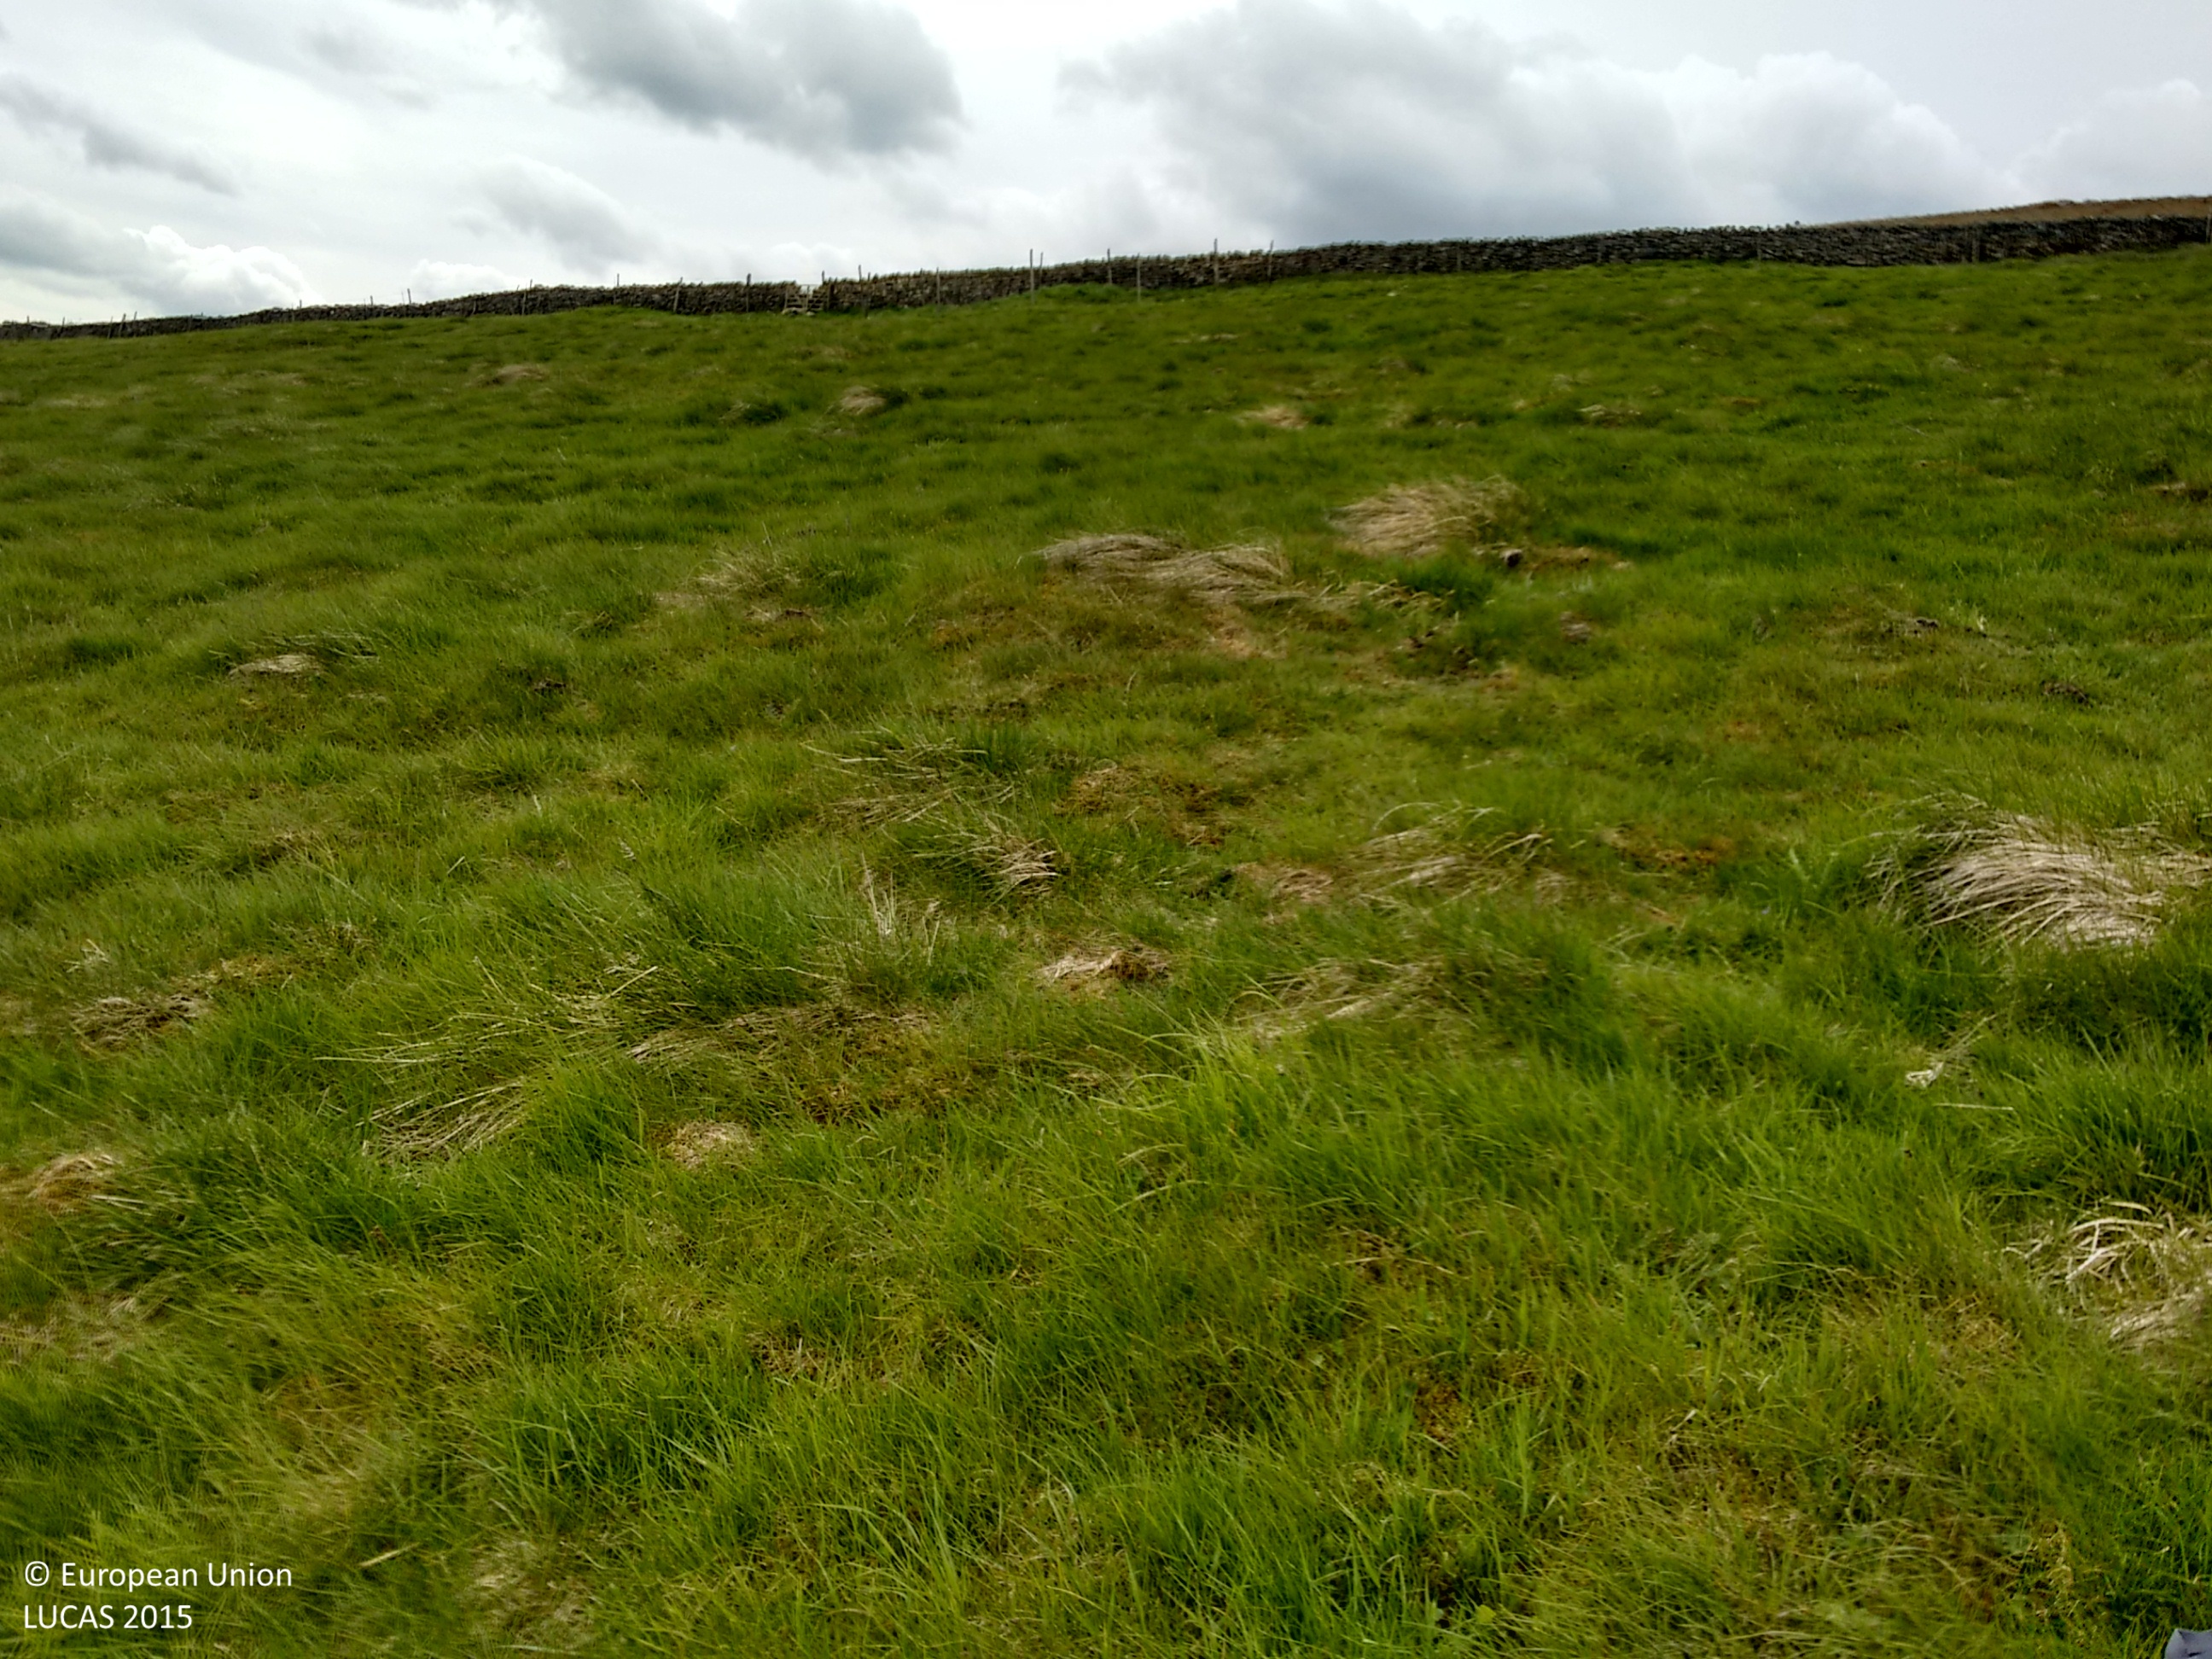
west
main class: Grassland
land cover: Grassland without tree/shrub cover
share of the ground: > 75 %
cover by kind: herbaceous plants 100 %
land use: Agriculture (excluding fallow land and kitchen gardens)
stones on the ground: < 10 %
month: June
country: GB
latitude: 54.0764
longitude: -1.8068
